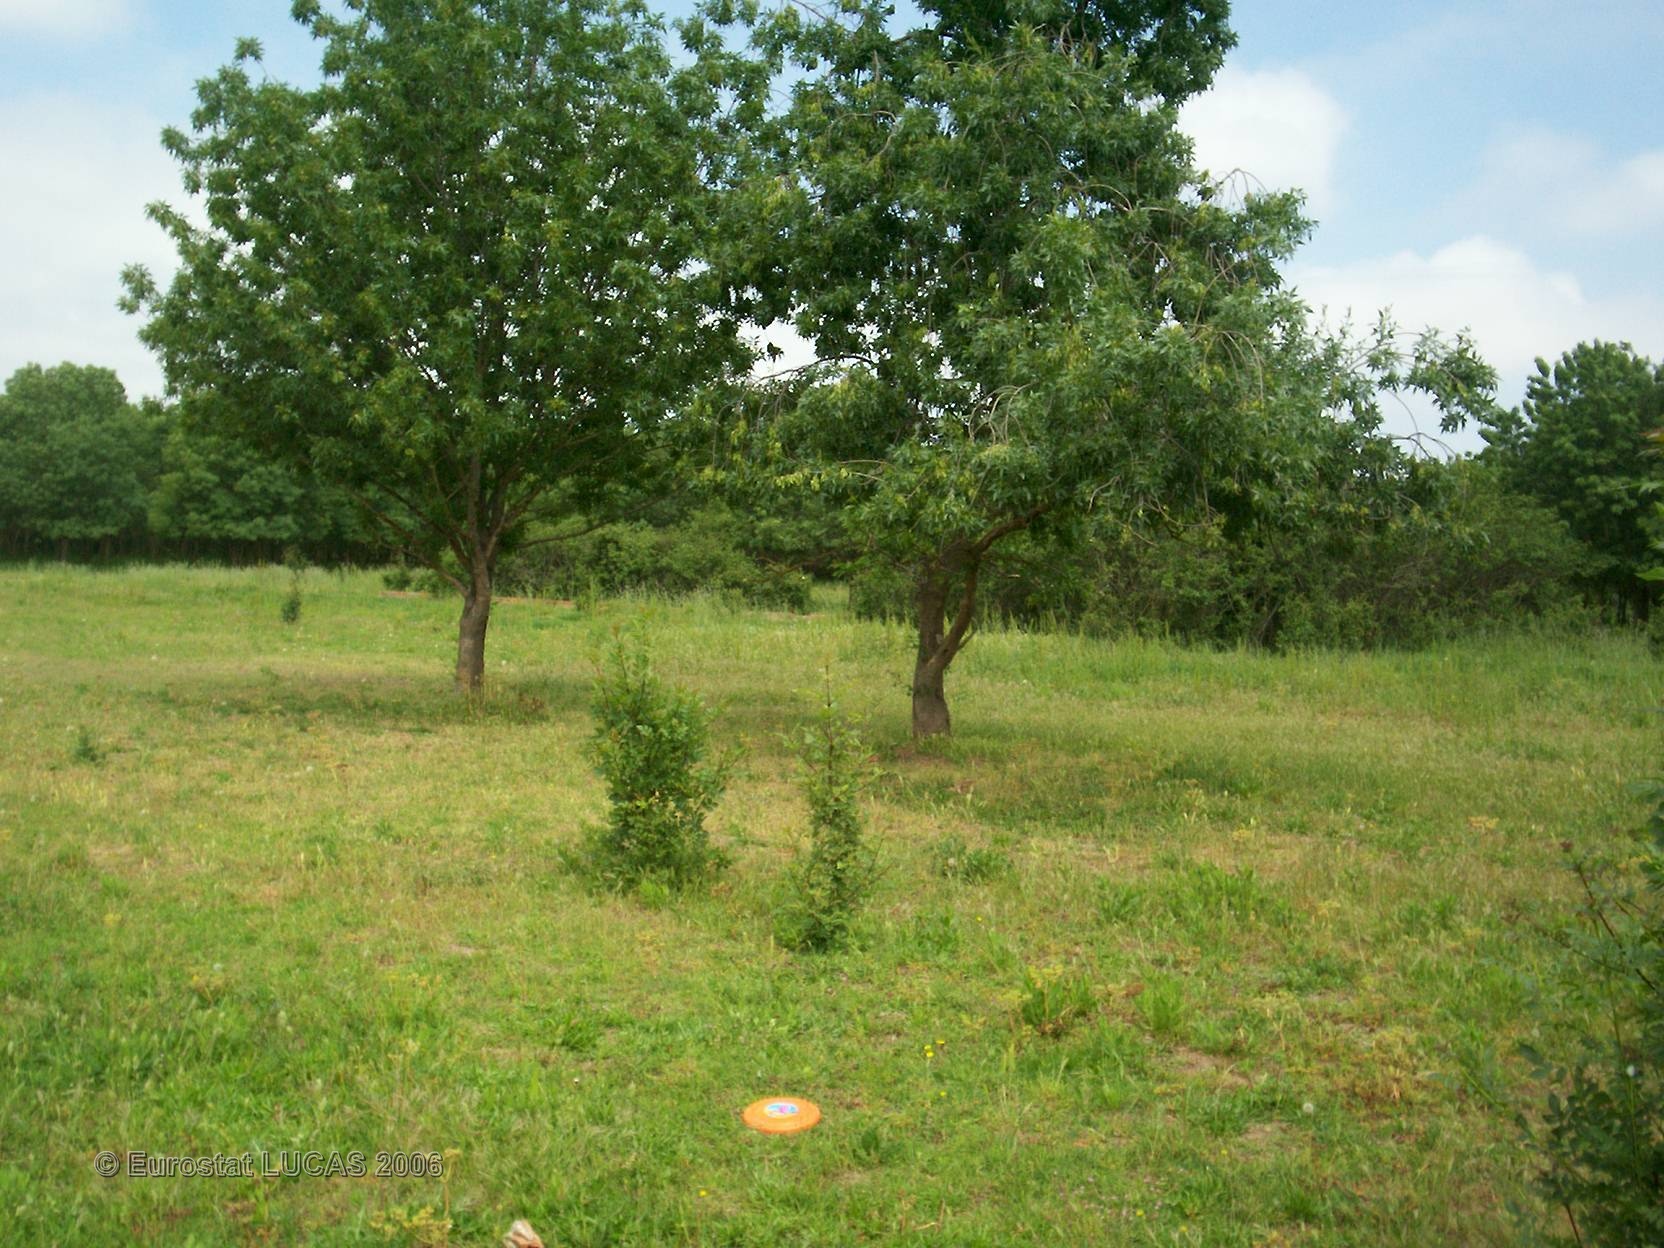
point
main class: Grassland
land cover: Grassland with sparse tree/shrub cover
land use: Agriculture (excluding fallow land and kitchen gardens)
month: May
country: FR
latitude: 43.3119
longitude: 3.4631
